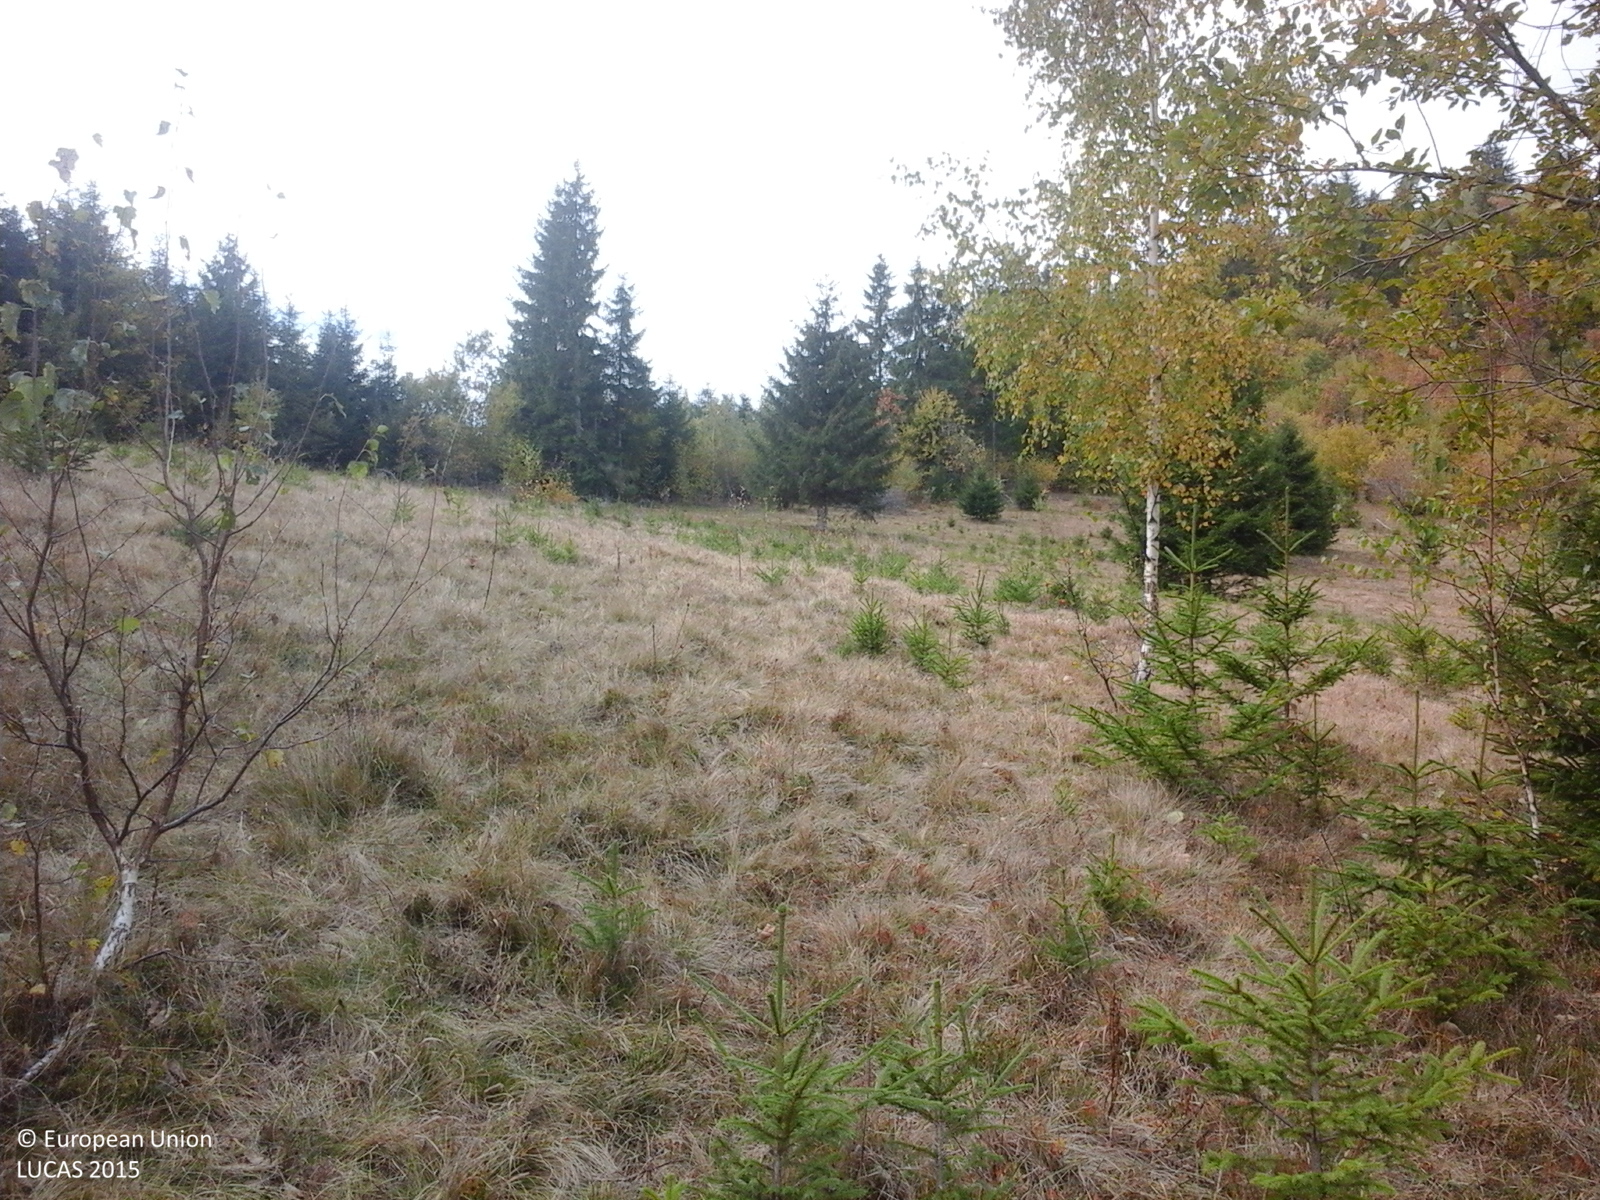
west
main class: Grassland
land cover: Grassland with sparse tree/shrub cover
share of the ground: > 75 %
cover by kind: herbaceous plants 85 %, shrubs 10 %, coniferous forest trees 5 %
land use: Forestry
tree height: < 5 m
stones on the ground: < 10 %
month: October
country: RO
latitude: 46.2896
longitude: 26.0208
